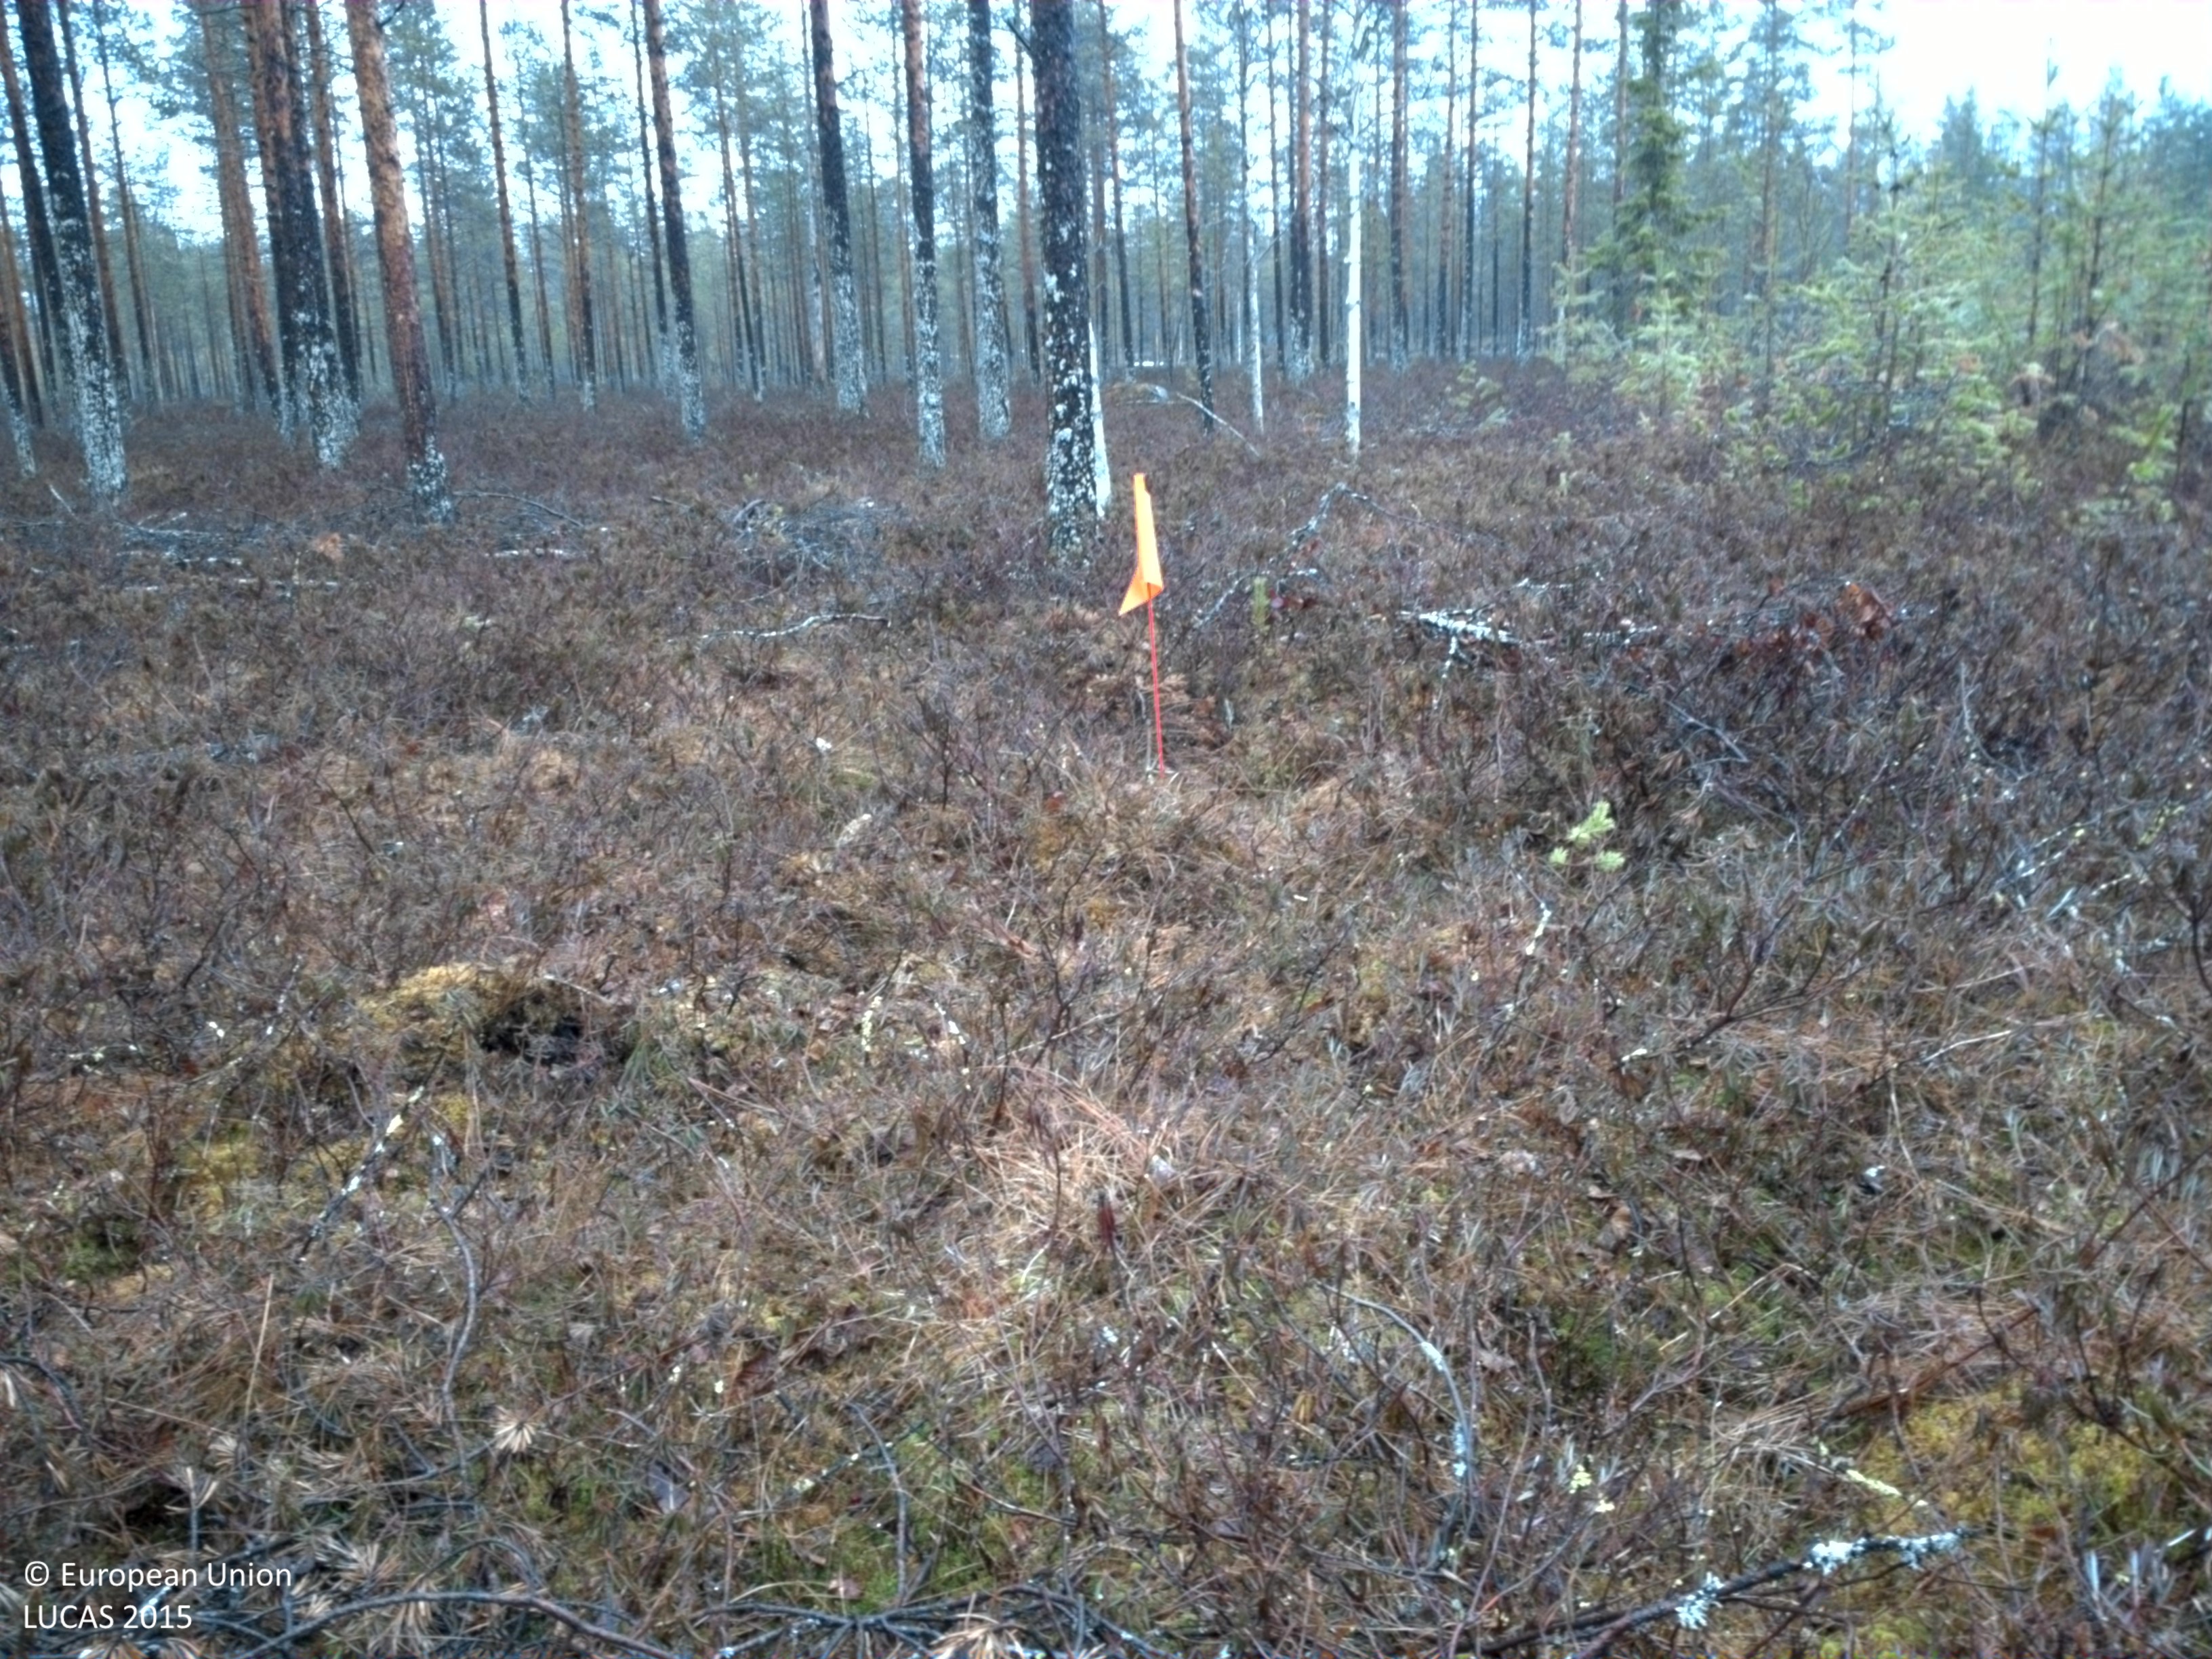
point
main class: Woodland
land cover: Pine dominated coniferous woodland
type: boreal forest
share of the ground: 50 - 75 %
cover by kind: coniferous forest trees 75 %, shrubs 25 %
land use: Forestry
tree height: > 5 m
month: May
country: SE
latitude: 65.8585
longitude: 23.2905
